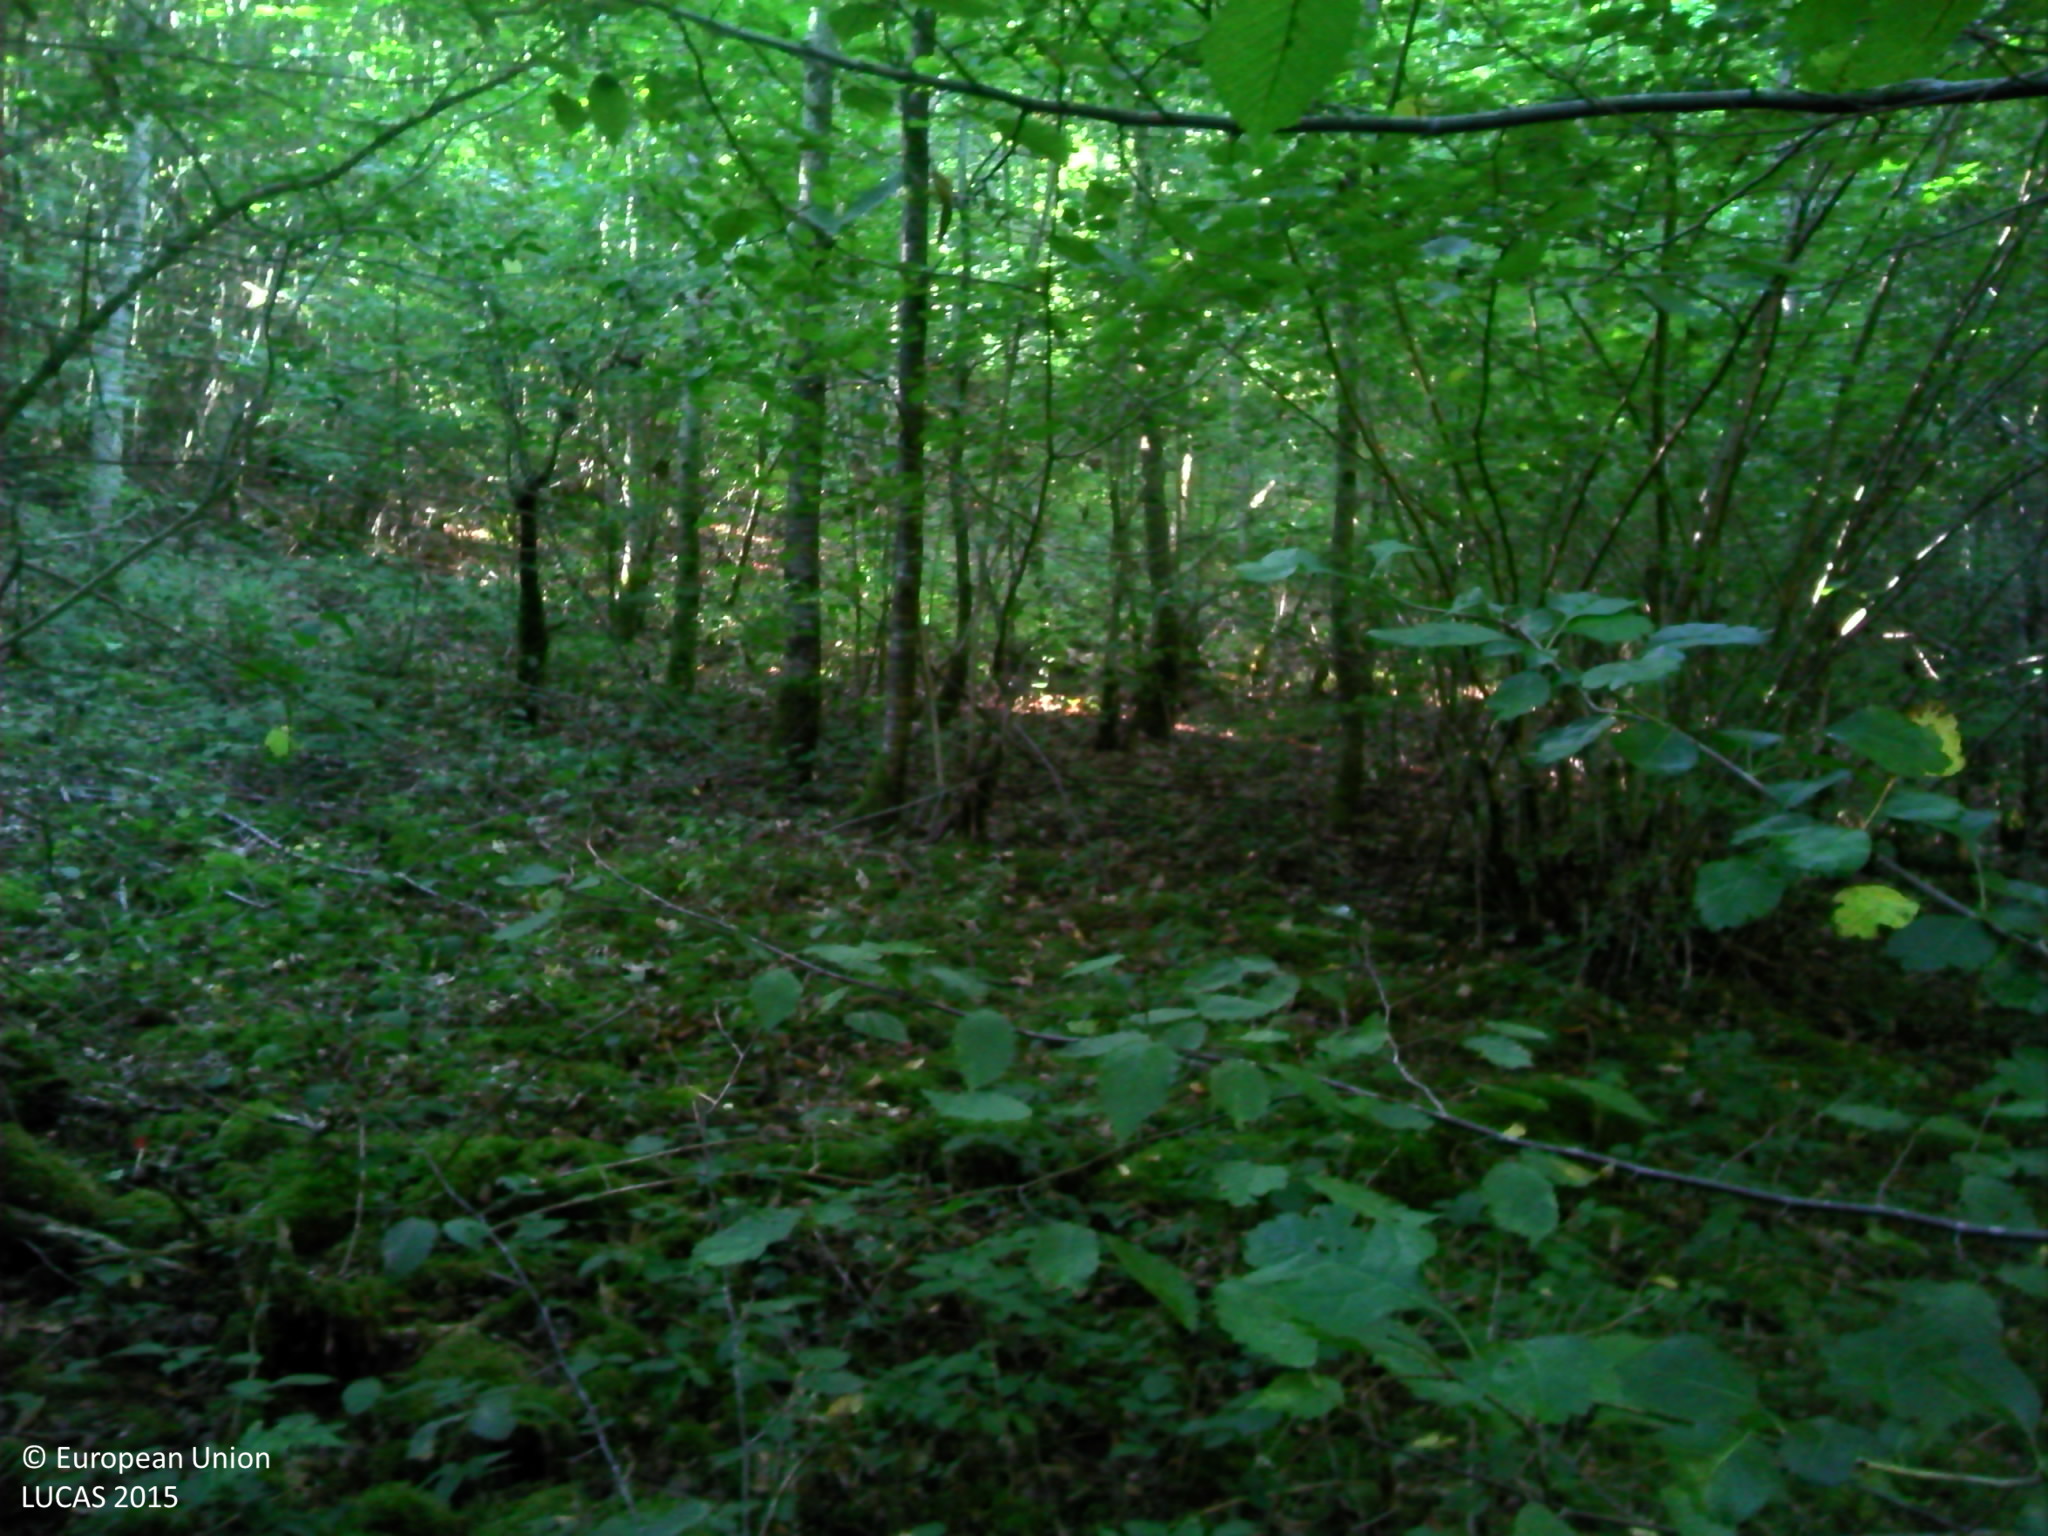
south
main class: Woodland
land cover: Spruce dominated mixed woodland
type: mesophytic deciduous forest
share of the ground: > 75 %
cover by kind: coniferous forest trees 40 %, broadleaved forest trees 40 %, shrubs 5 %, herbaceous plants 5 %, lichens and mosses 5 %, consolidated bare surface 5 %
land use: Forestry
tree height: > 5 m
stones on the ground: < 10 %
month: September
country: FR
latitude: 47.2782
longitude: 6.2871
